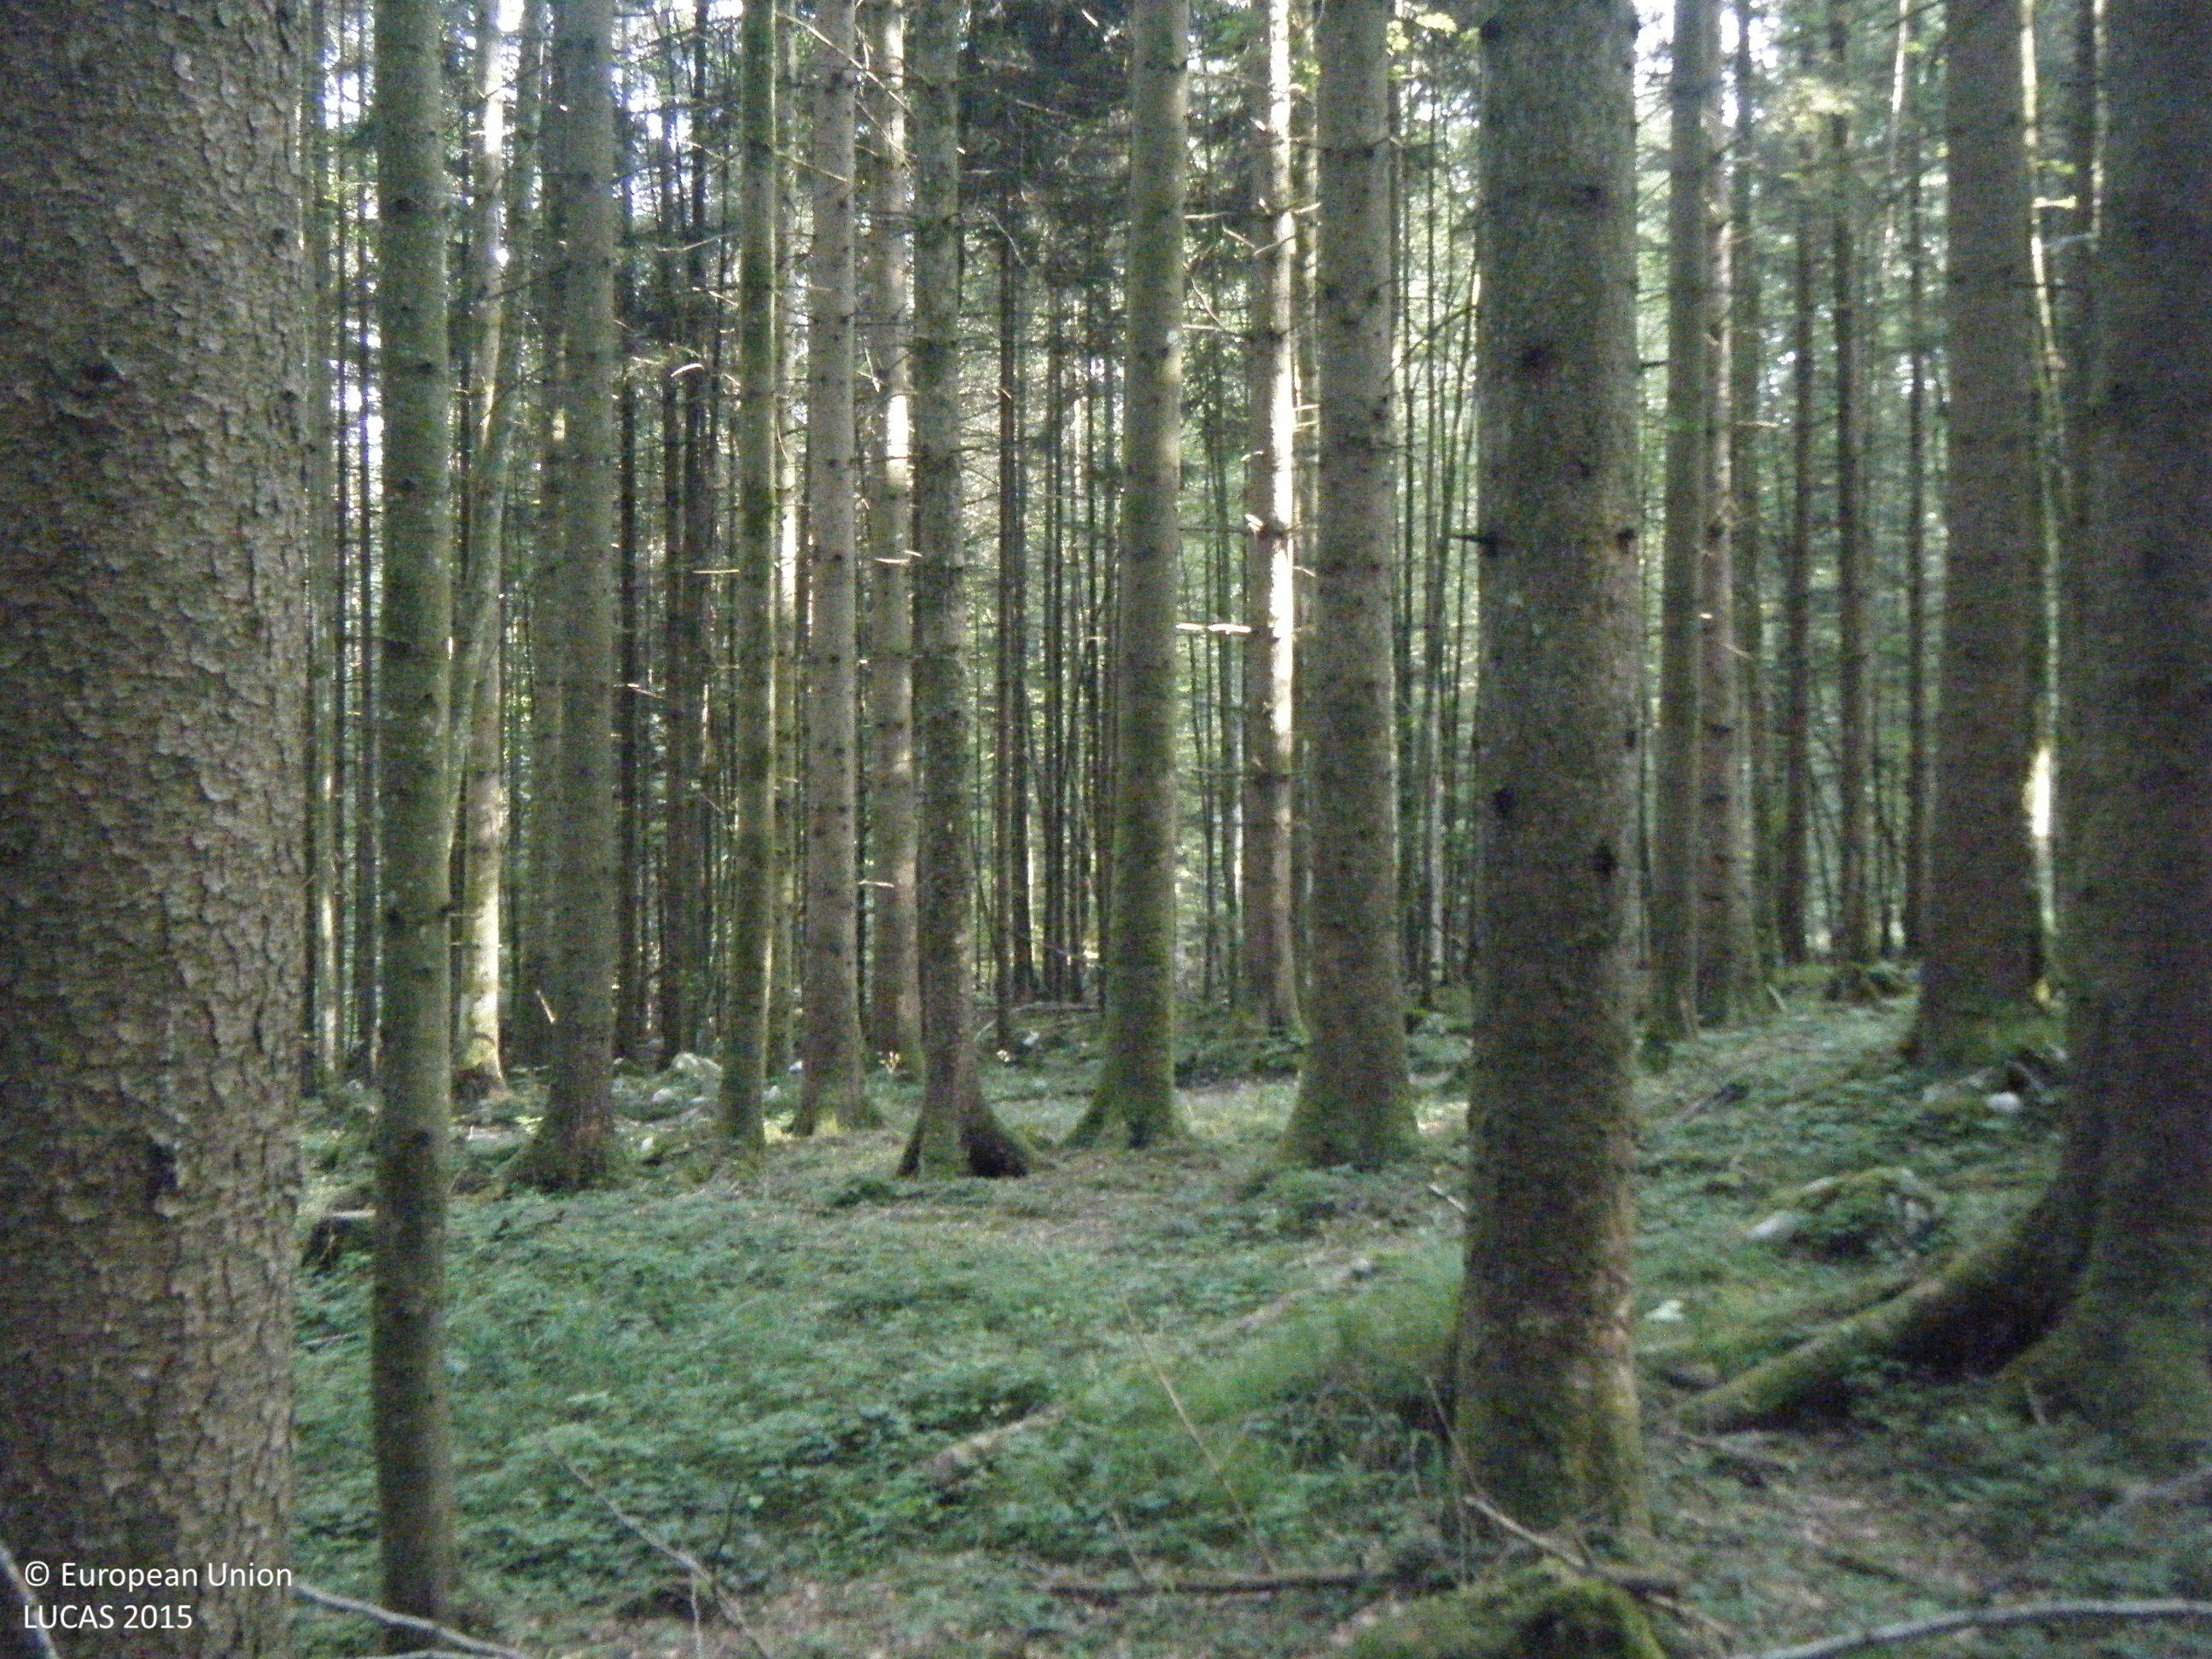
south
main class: Woodland
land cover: Spruce dominated mixed woodland
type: alpine coniferous forest
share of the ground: > 75 %
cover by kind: coniferous forest trees 55 %, broadleaved forest trees 25 %, herbaceous plants 15 %, lichens and mosses 5 %
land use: Forestry
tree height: > 5 m
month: July
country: AT
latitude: 47.7364
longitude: 13.4791
